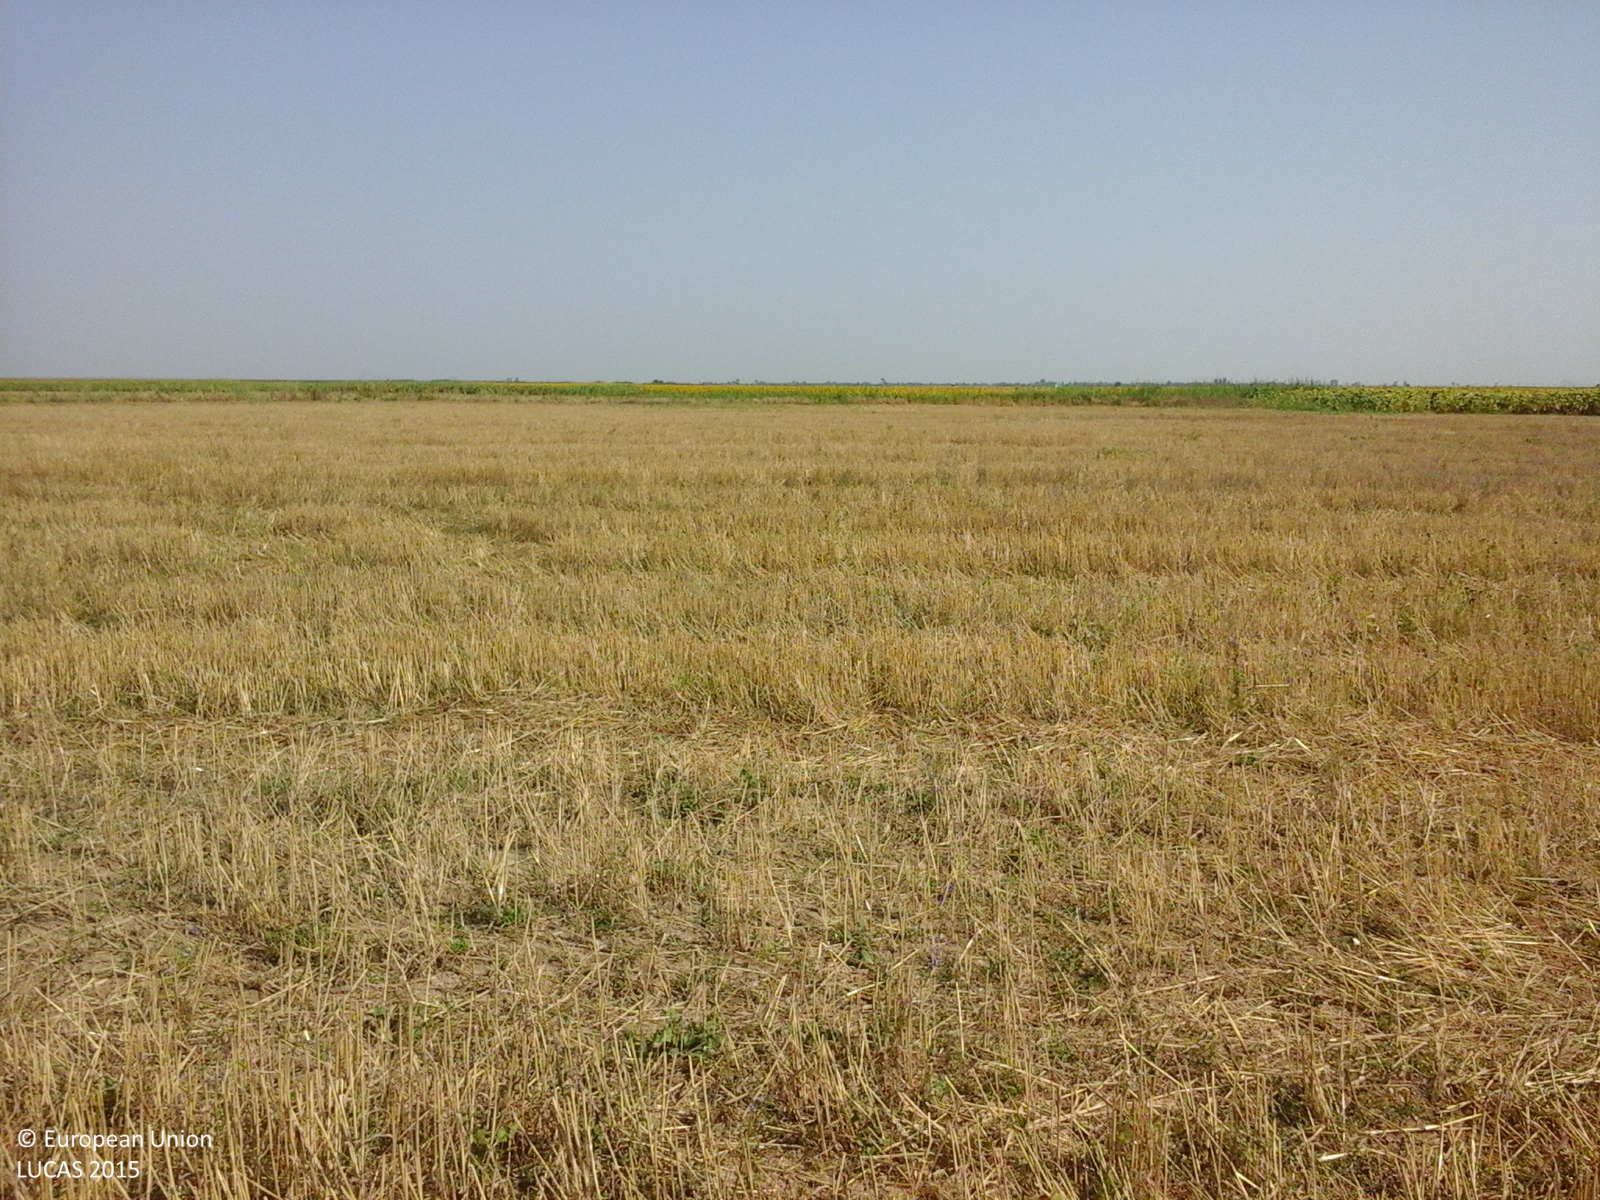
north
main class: Cropland
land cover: Common wheat
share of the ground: > 75 %
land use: Agriculture (excluding fallow land and kitchen gardens)
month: August
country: RO
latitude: 45.3767
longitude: 27.5856
